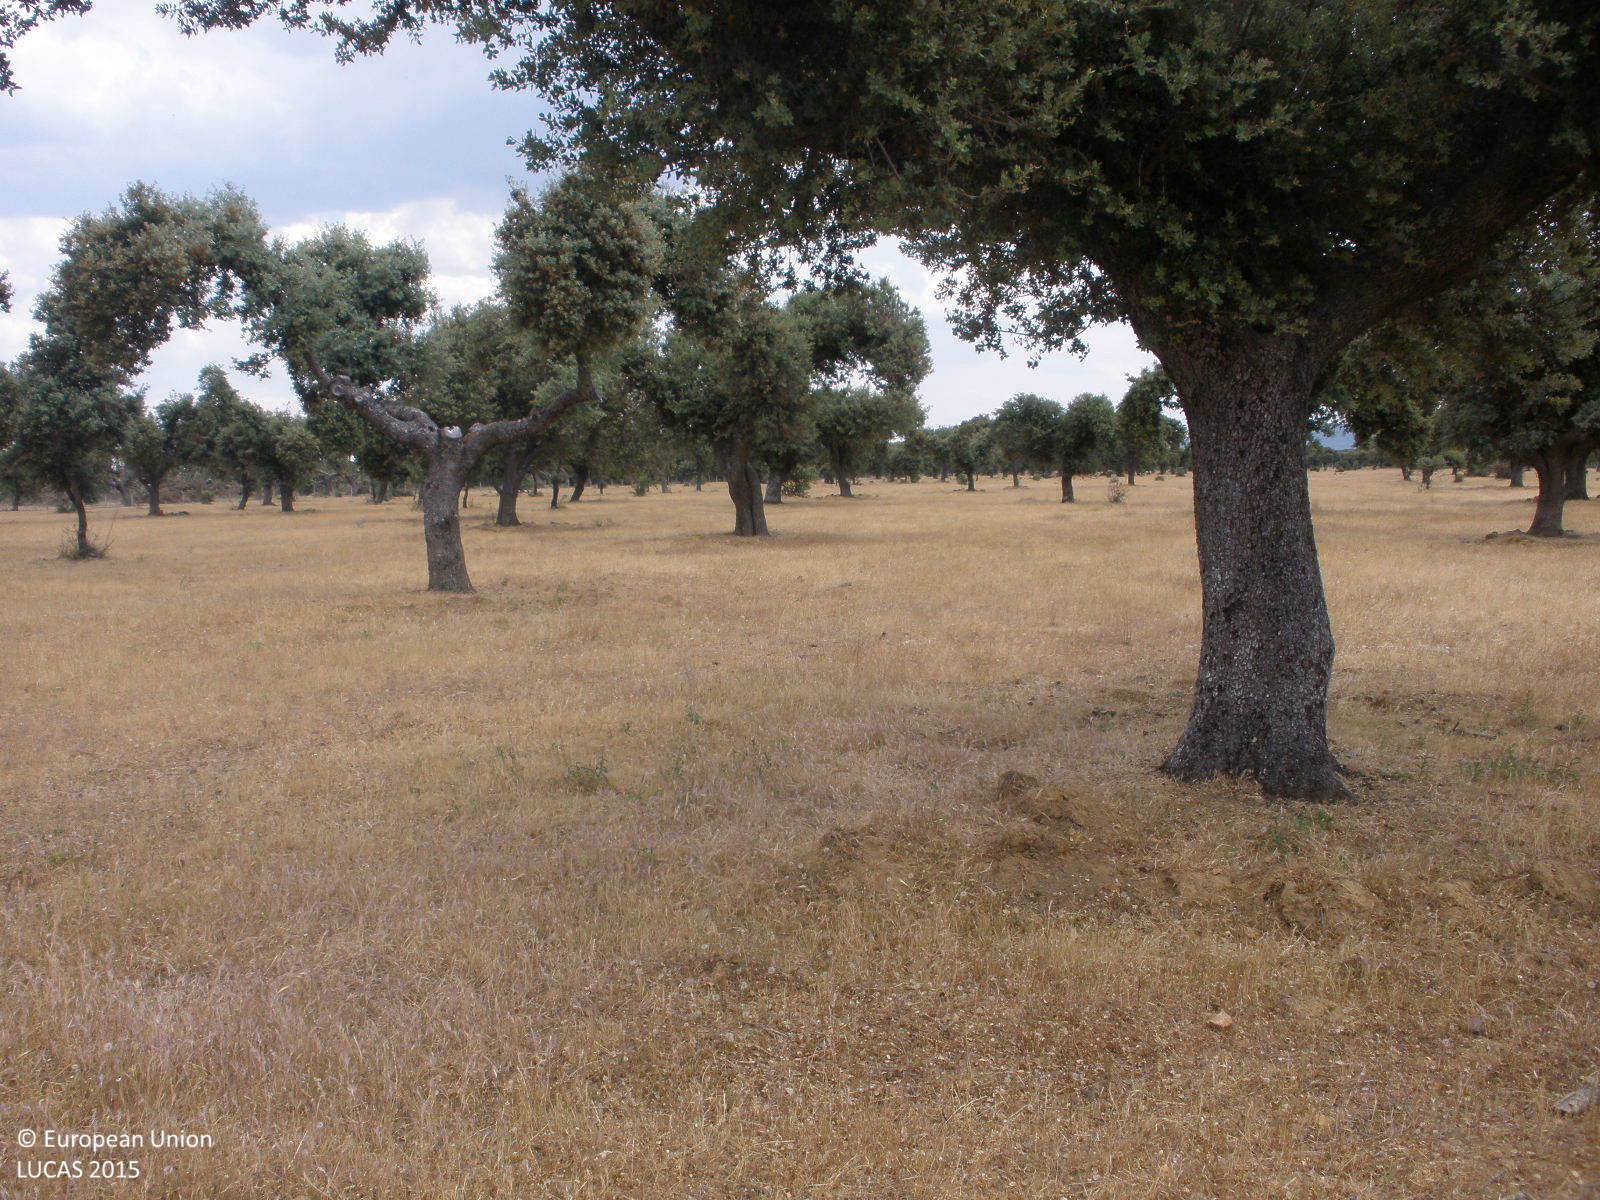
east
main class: Woodland
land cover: Broadleaved woodland
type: broadleaved evergreen forest
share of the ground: 25 - 50 %
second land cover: Grassland without tree/shrub cover
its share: > 75 %
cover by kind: herbaceous plants 70 %, broadleaved forest trees 30 %
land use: Forestry
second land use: Agriculture (excluding fallow land and kitchen gardens)
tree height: > 5 m
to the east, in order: Broadleaved woodland; Grassland without tree/shrub cover; Electric lines; Broadleaved woodland; Grassland with sparse tree/shrub cover; Broadleaved woodland
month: June
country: ES
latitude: 40.6447
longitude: -6.1770
